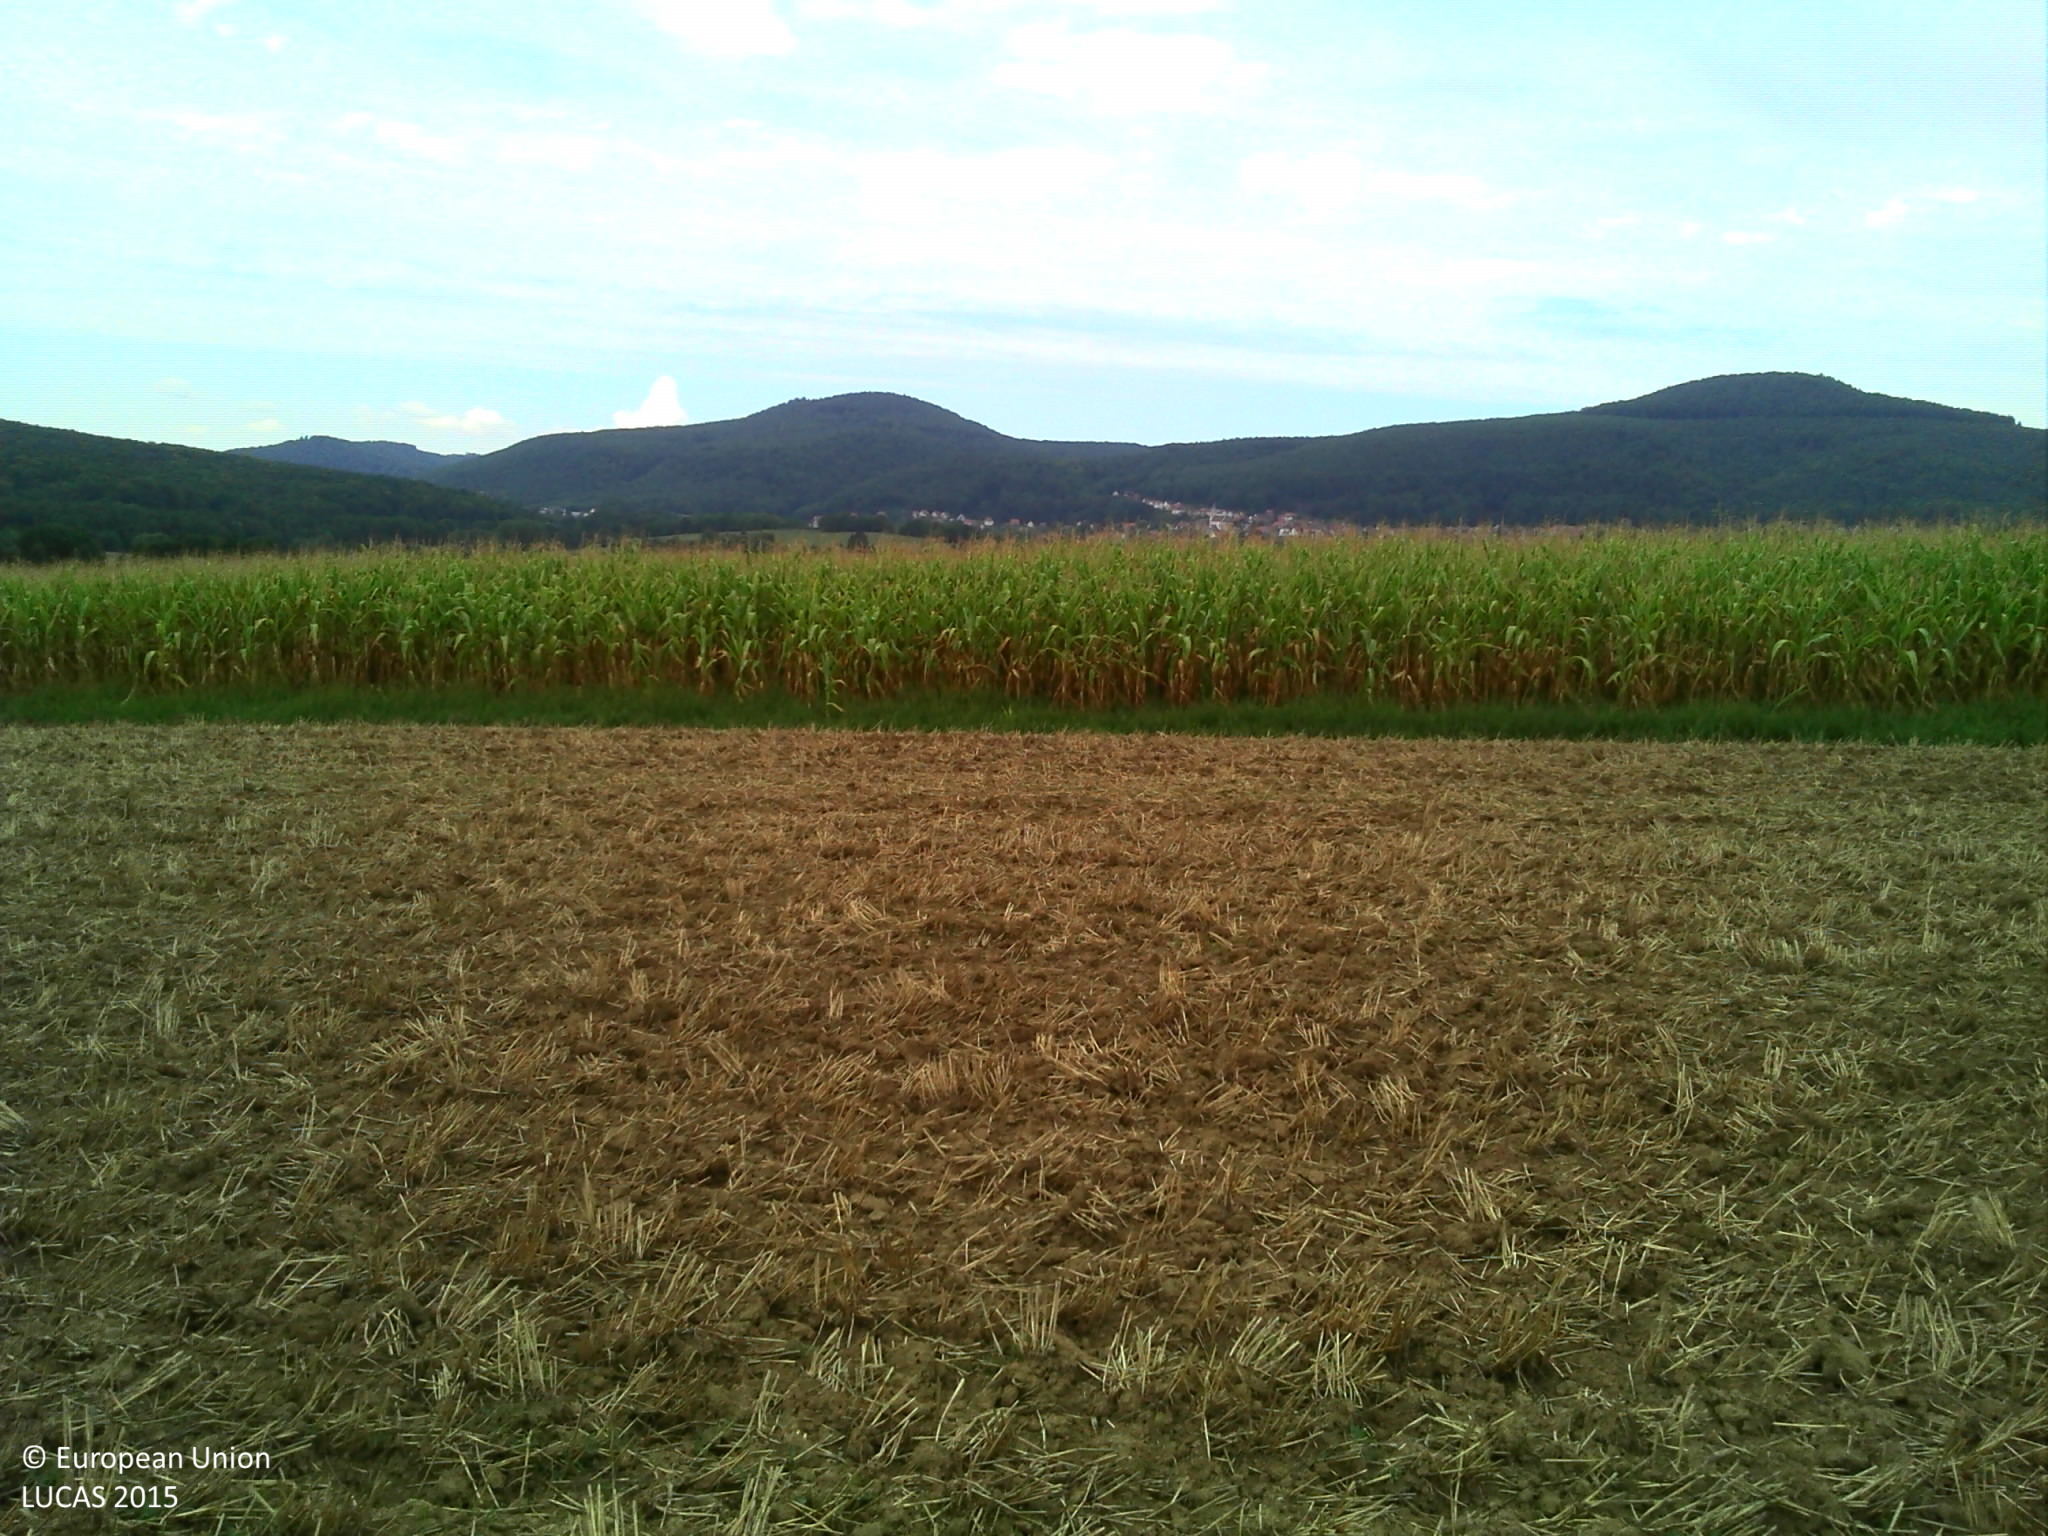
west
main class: Cropland
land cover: Common wheat
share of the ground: 10 - 25 %
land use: Agriculture (excluding fallow land and kitchen gardens)
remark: Harvested field
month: August
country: FR
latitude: 48.9363
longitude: 7.6390
